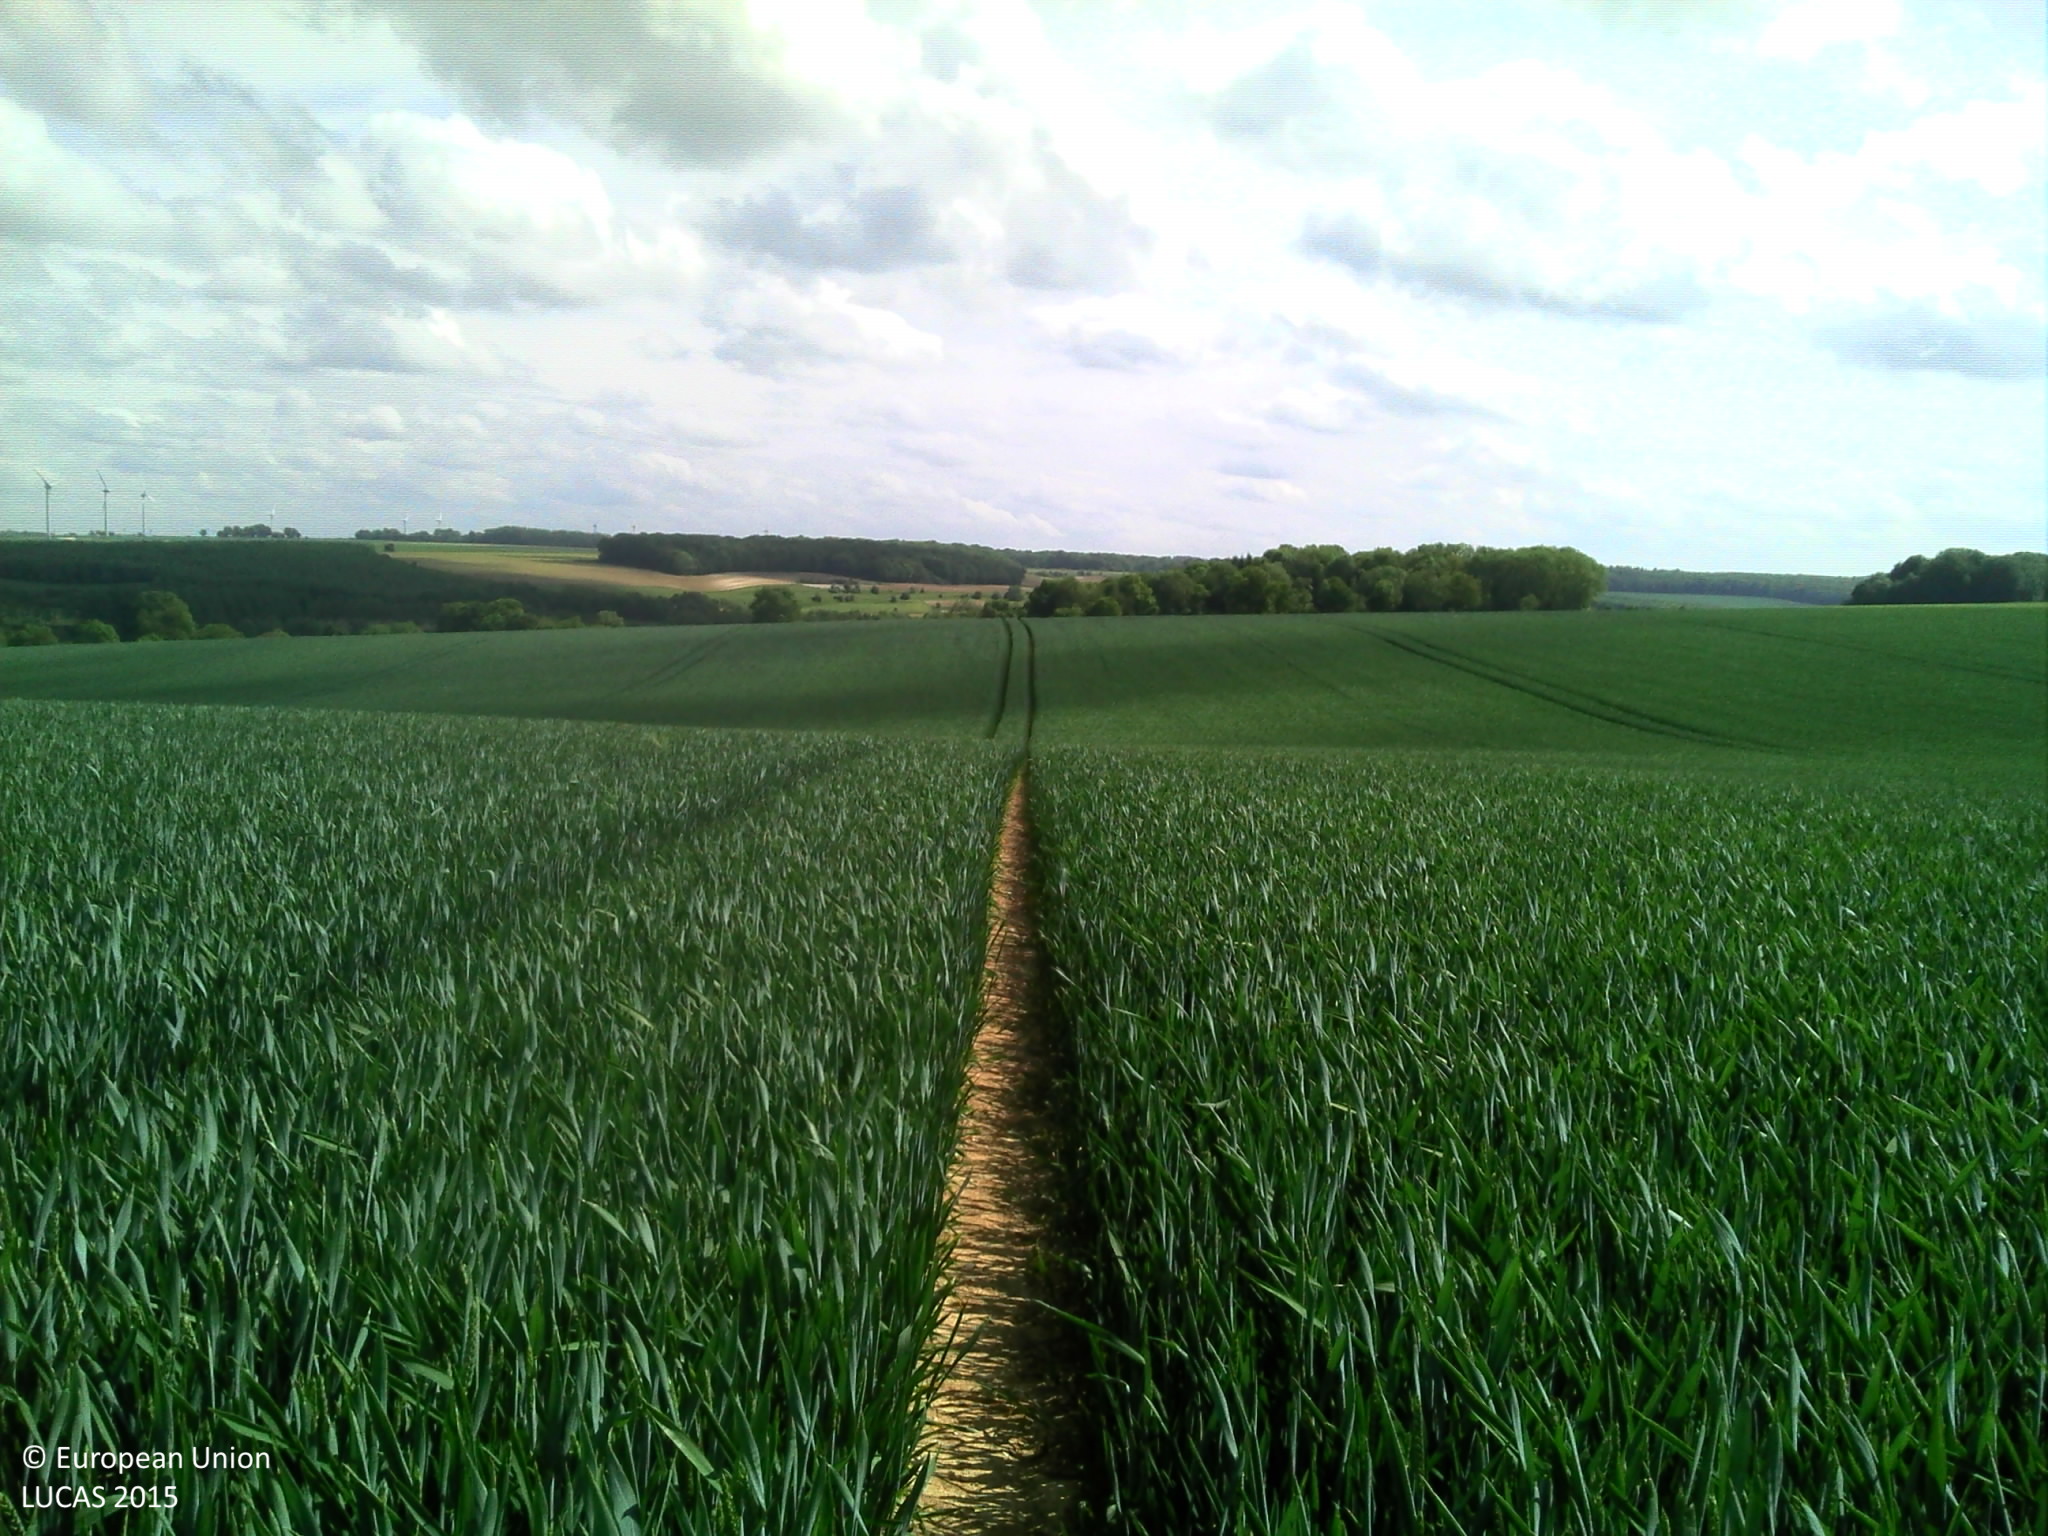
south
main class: Cropland
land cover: Common wheat
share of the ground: > 75 %
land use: Agriculture (excluding fallow land and kitchen gardens)
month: May
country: FR
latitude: 50.0181
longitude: 1.5940
